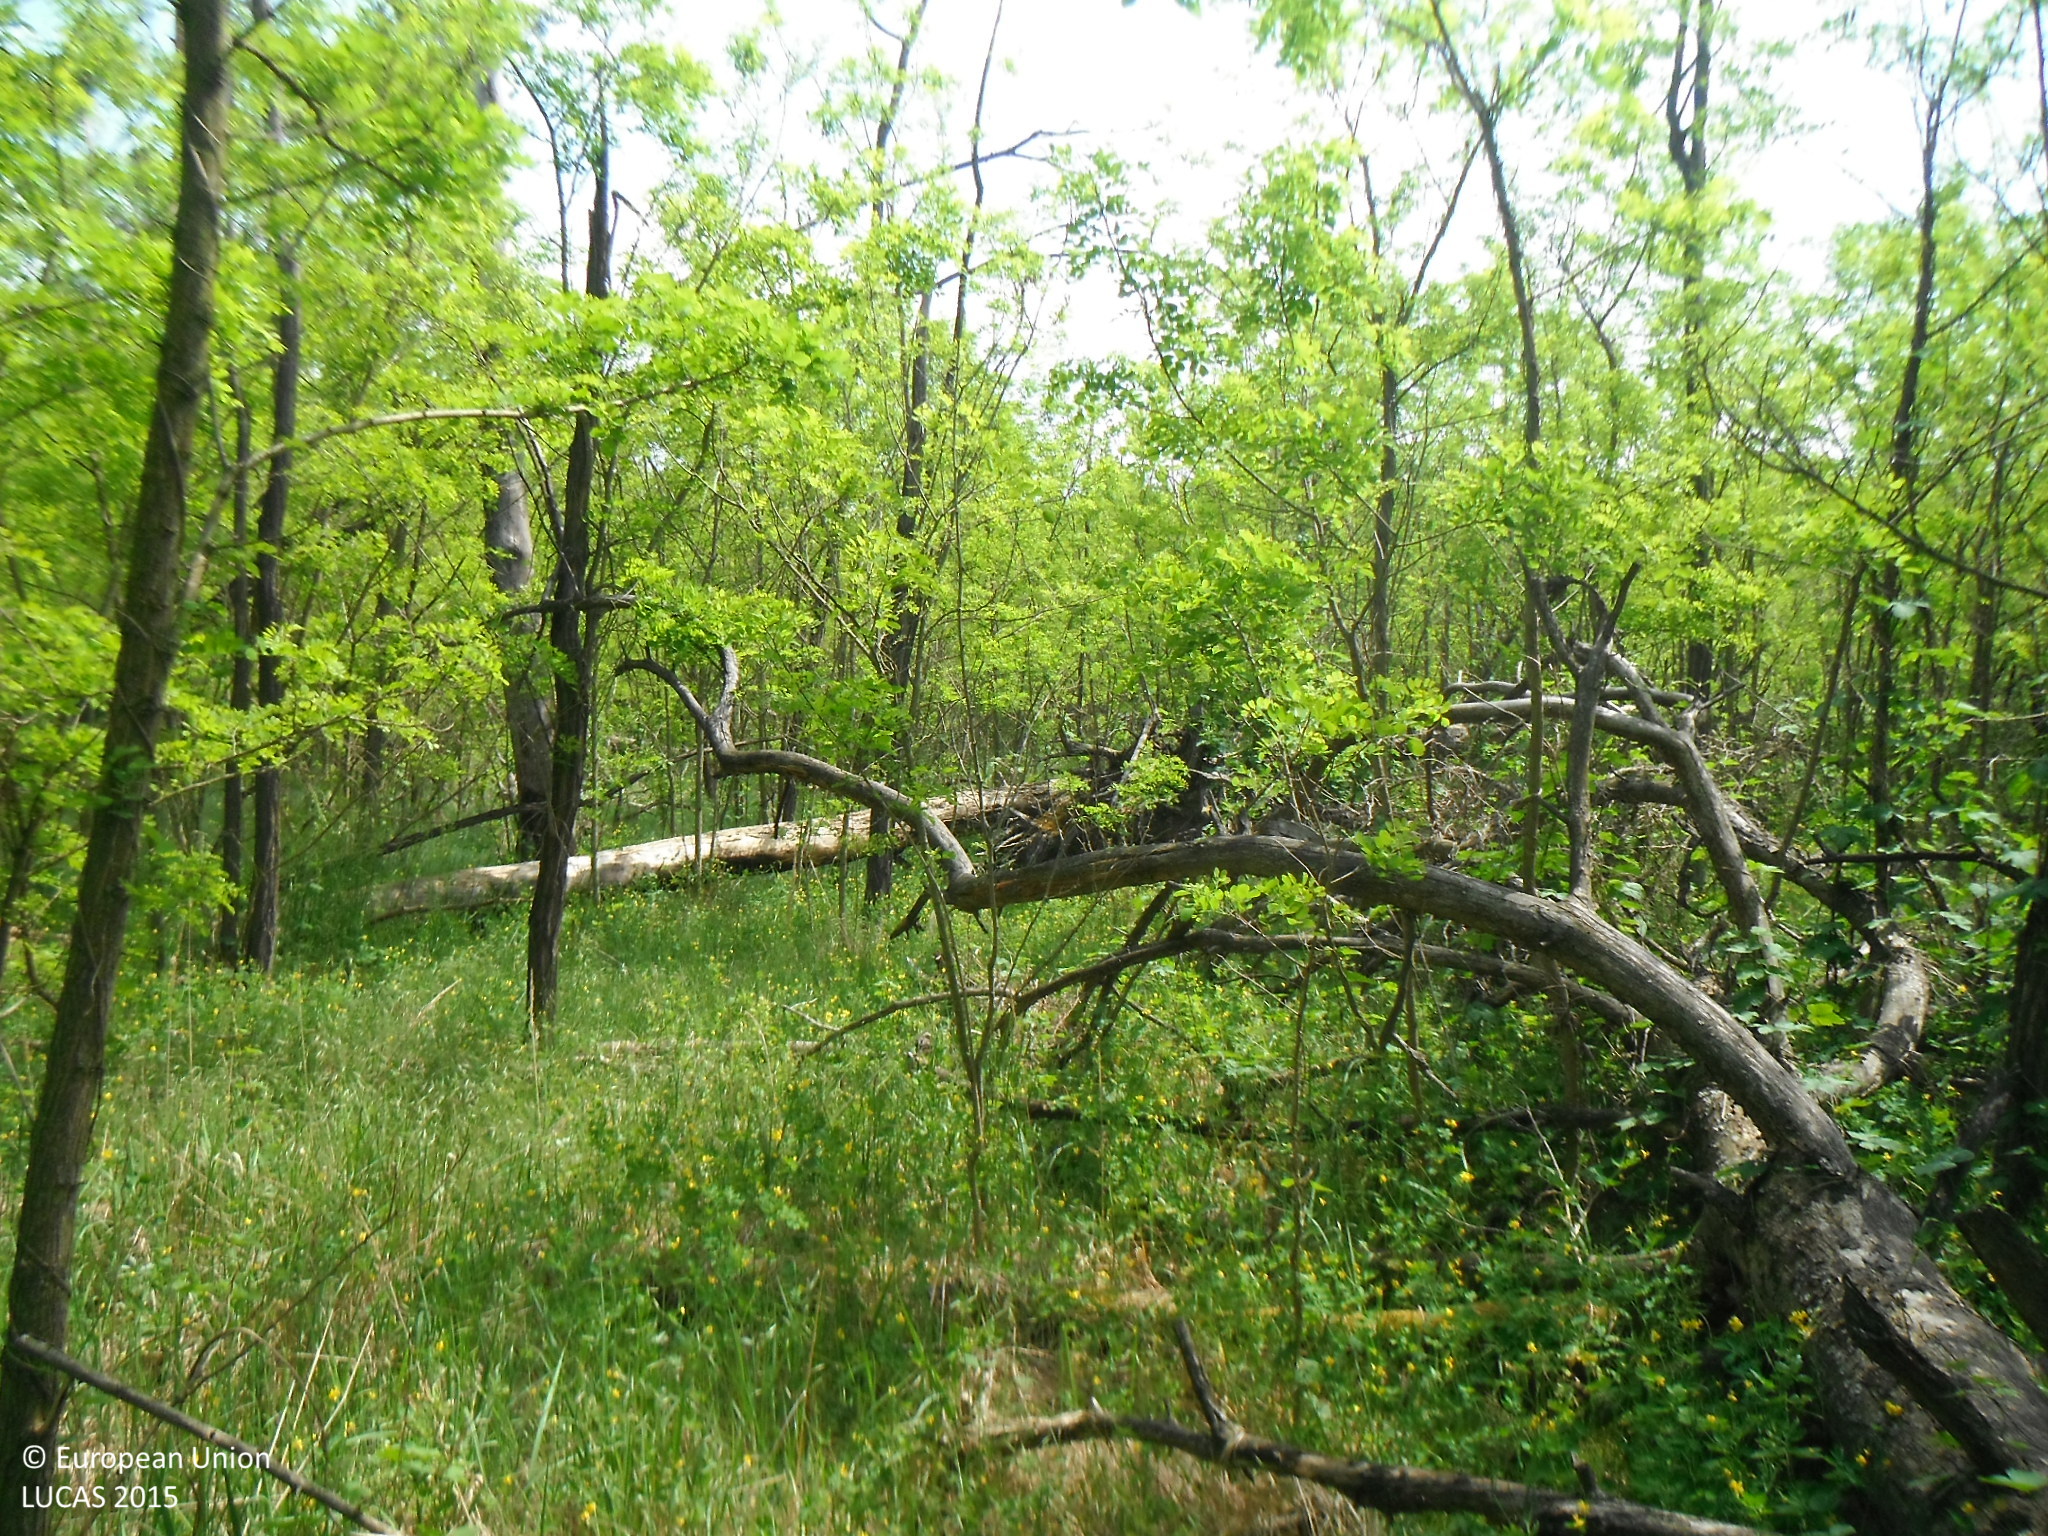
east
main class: Woodland
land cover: Broadleaved woodland
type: exotic forest
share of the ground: 50 - 75 %
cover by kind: broadleaved forest trees 60 %, shrubs 20 %, herbaceous plants 20 %
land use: Forestry
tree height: > 5 m
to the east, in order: Broadleaved woodland; Shrubland with sparse tree cover; Broadleaved woodland; Spontaneously vegetated surfaces; Inland marshes; Single bushes/trees; Spontaneously vegetated surfaces; Ditches and canals; Spontaneously vegetated surfaces; Pine dominated coniferous woodland
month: May
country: SK
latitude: 48.4218
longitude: 16.9127
